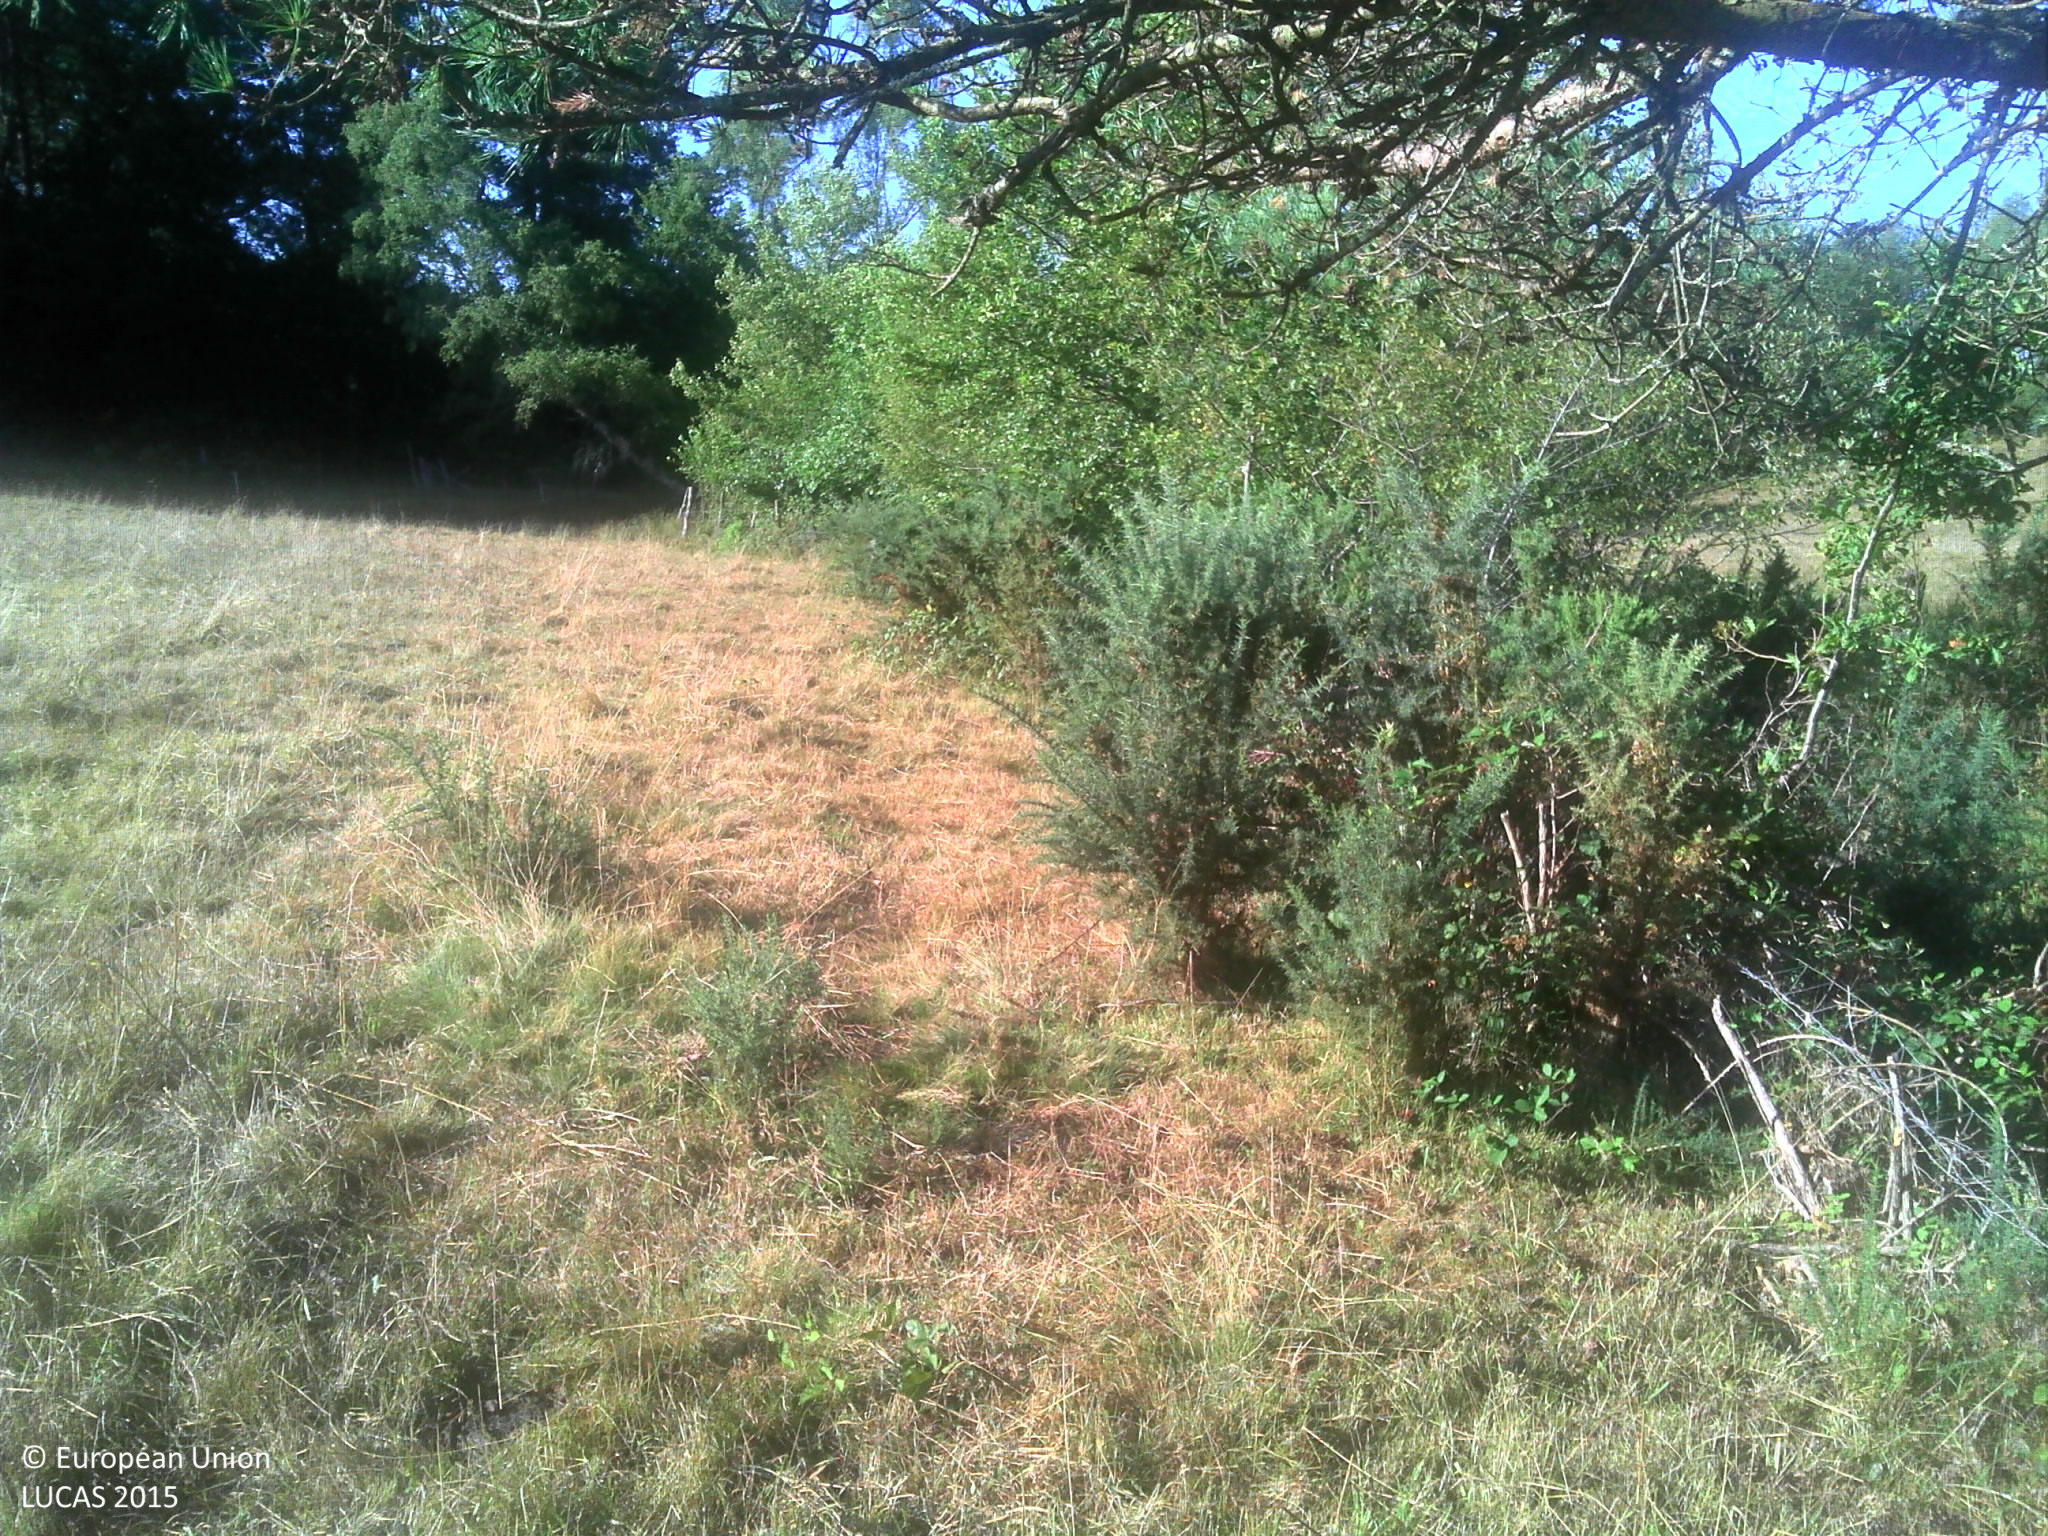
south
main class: Grassland
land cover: Grassland without tree/shrub cover
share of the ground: > 75 %
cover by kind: herbaceous plants 95 %, shrubs 5 %
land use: Agriculture (excluding fallow land and kitchen gardens)
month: August
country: FR
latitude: 45.3173
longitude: 1.8705
